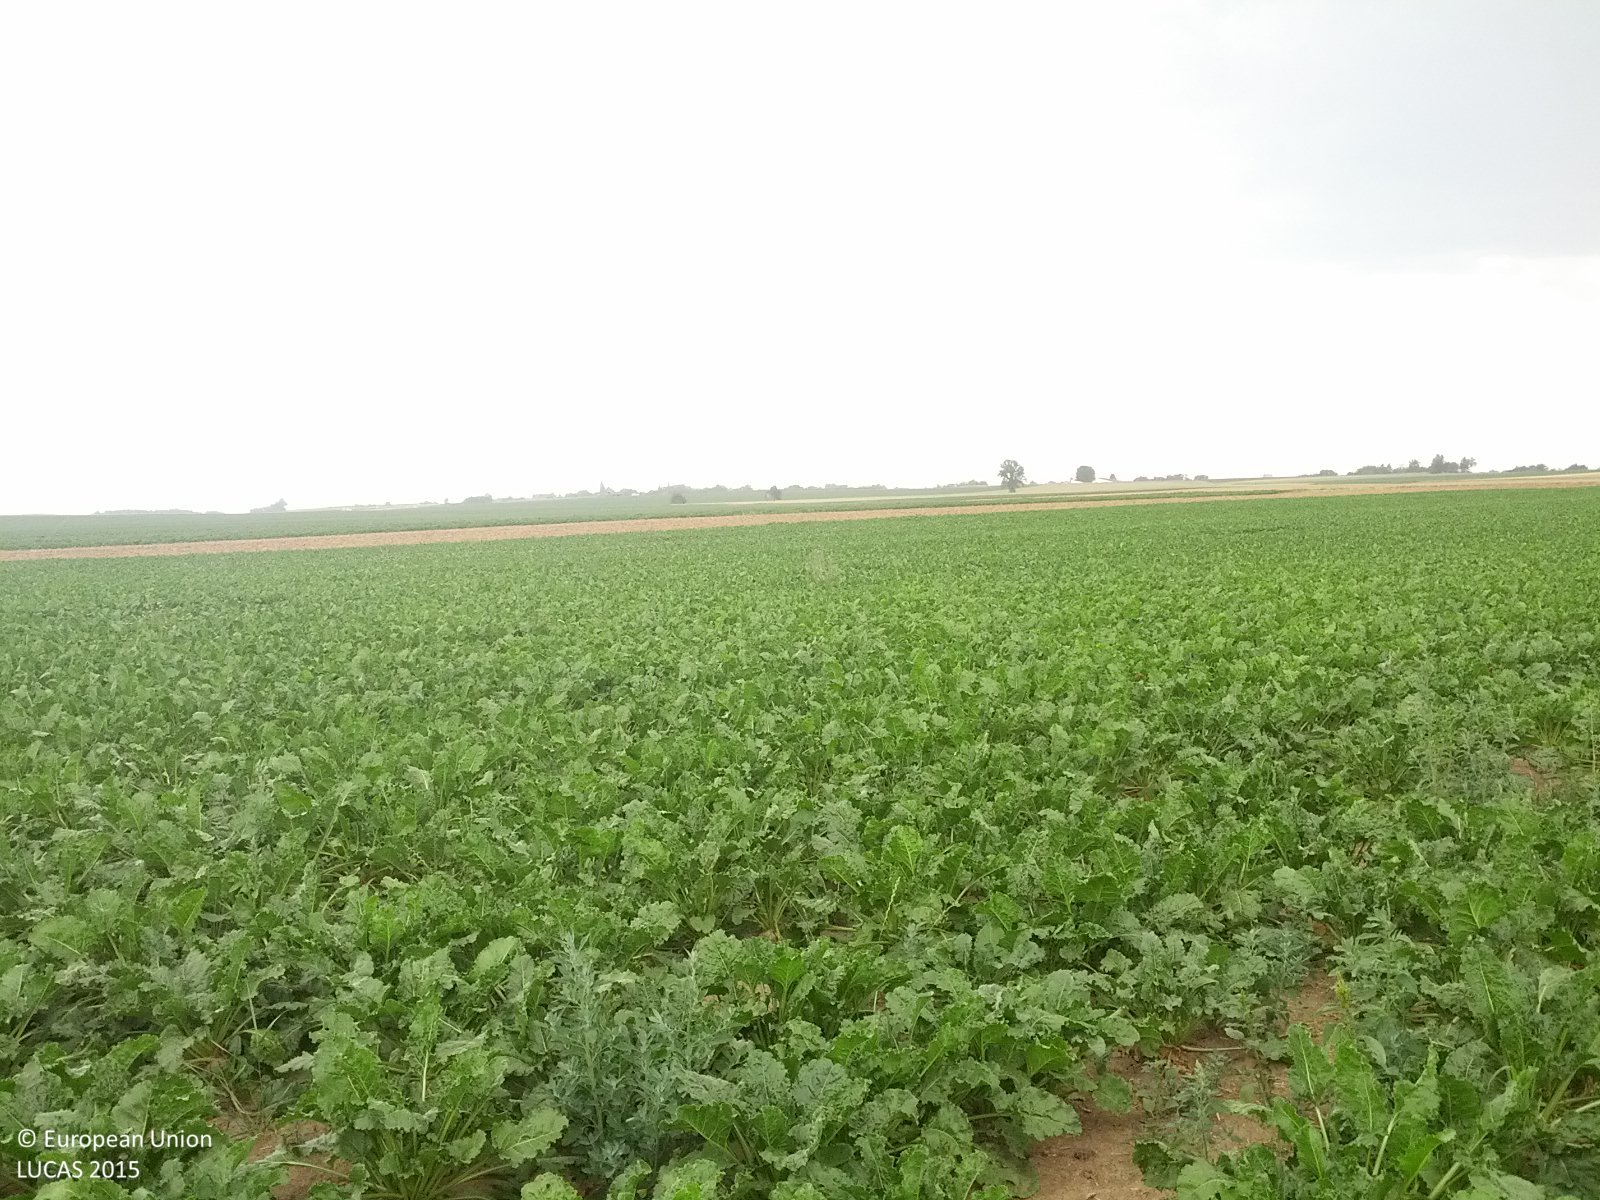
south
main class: Cropland
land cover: Sugar beet
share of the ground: > 75 %
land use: Agriculture (excluding fallow land and kitchen gardens)
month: July
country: AT
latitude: 48.4171
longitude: 16.0711
